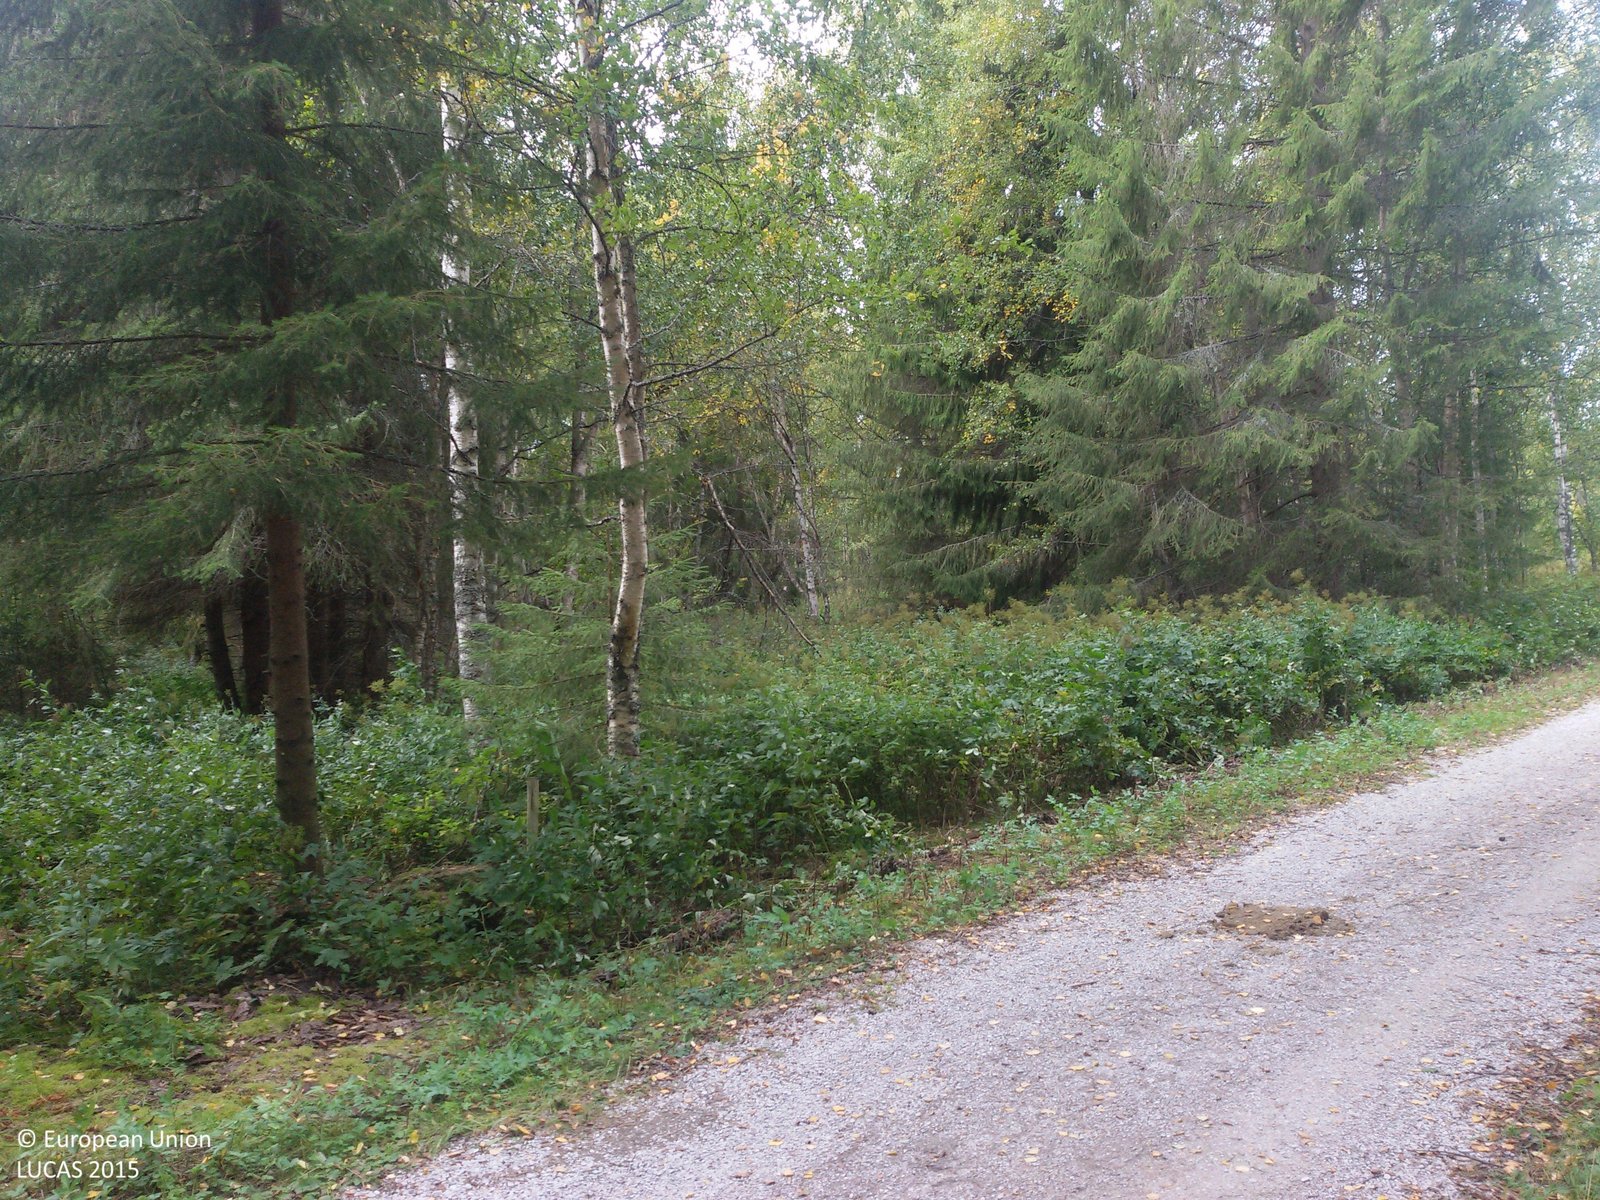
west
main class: Woodland
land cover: Spruce dominated mixed woodland
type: boreal forest
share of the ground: > 75 %
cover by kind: coniferous forest trees 60 %, broadleaved forest trees 20 %, herbaceous plants 10 %, lichens and mosses 10 %
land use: Forestry
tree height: > 5 m
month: September
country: SE
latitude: 60.9136
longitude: 15.2419
